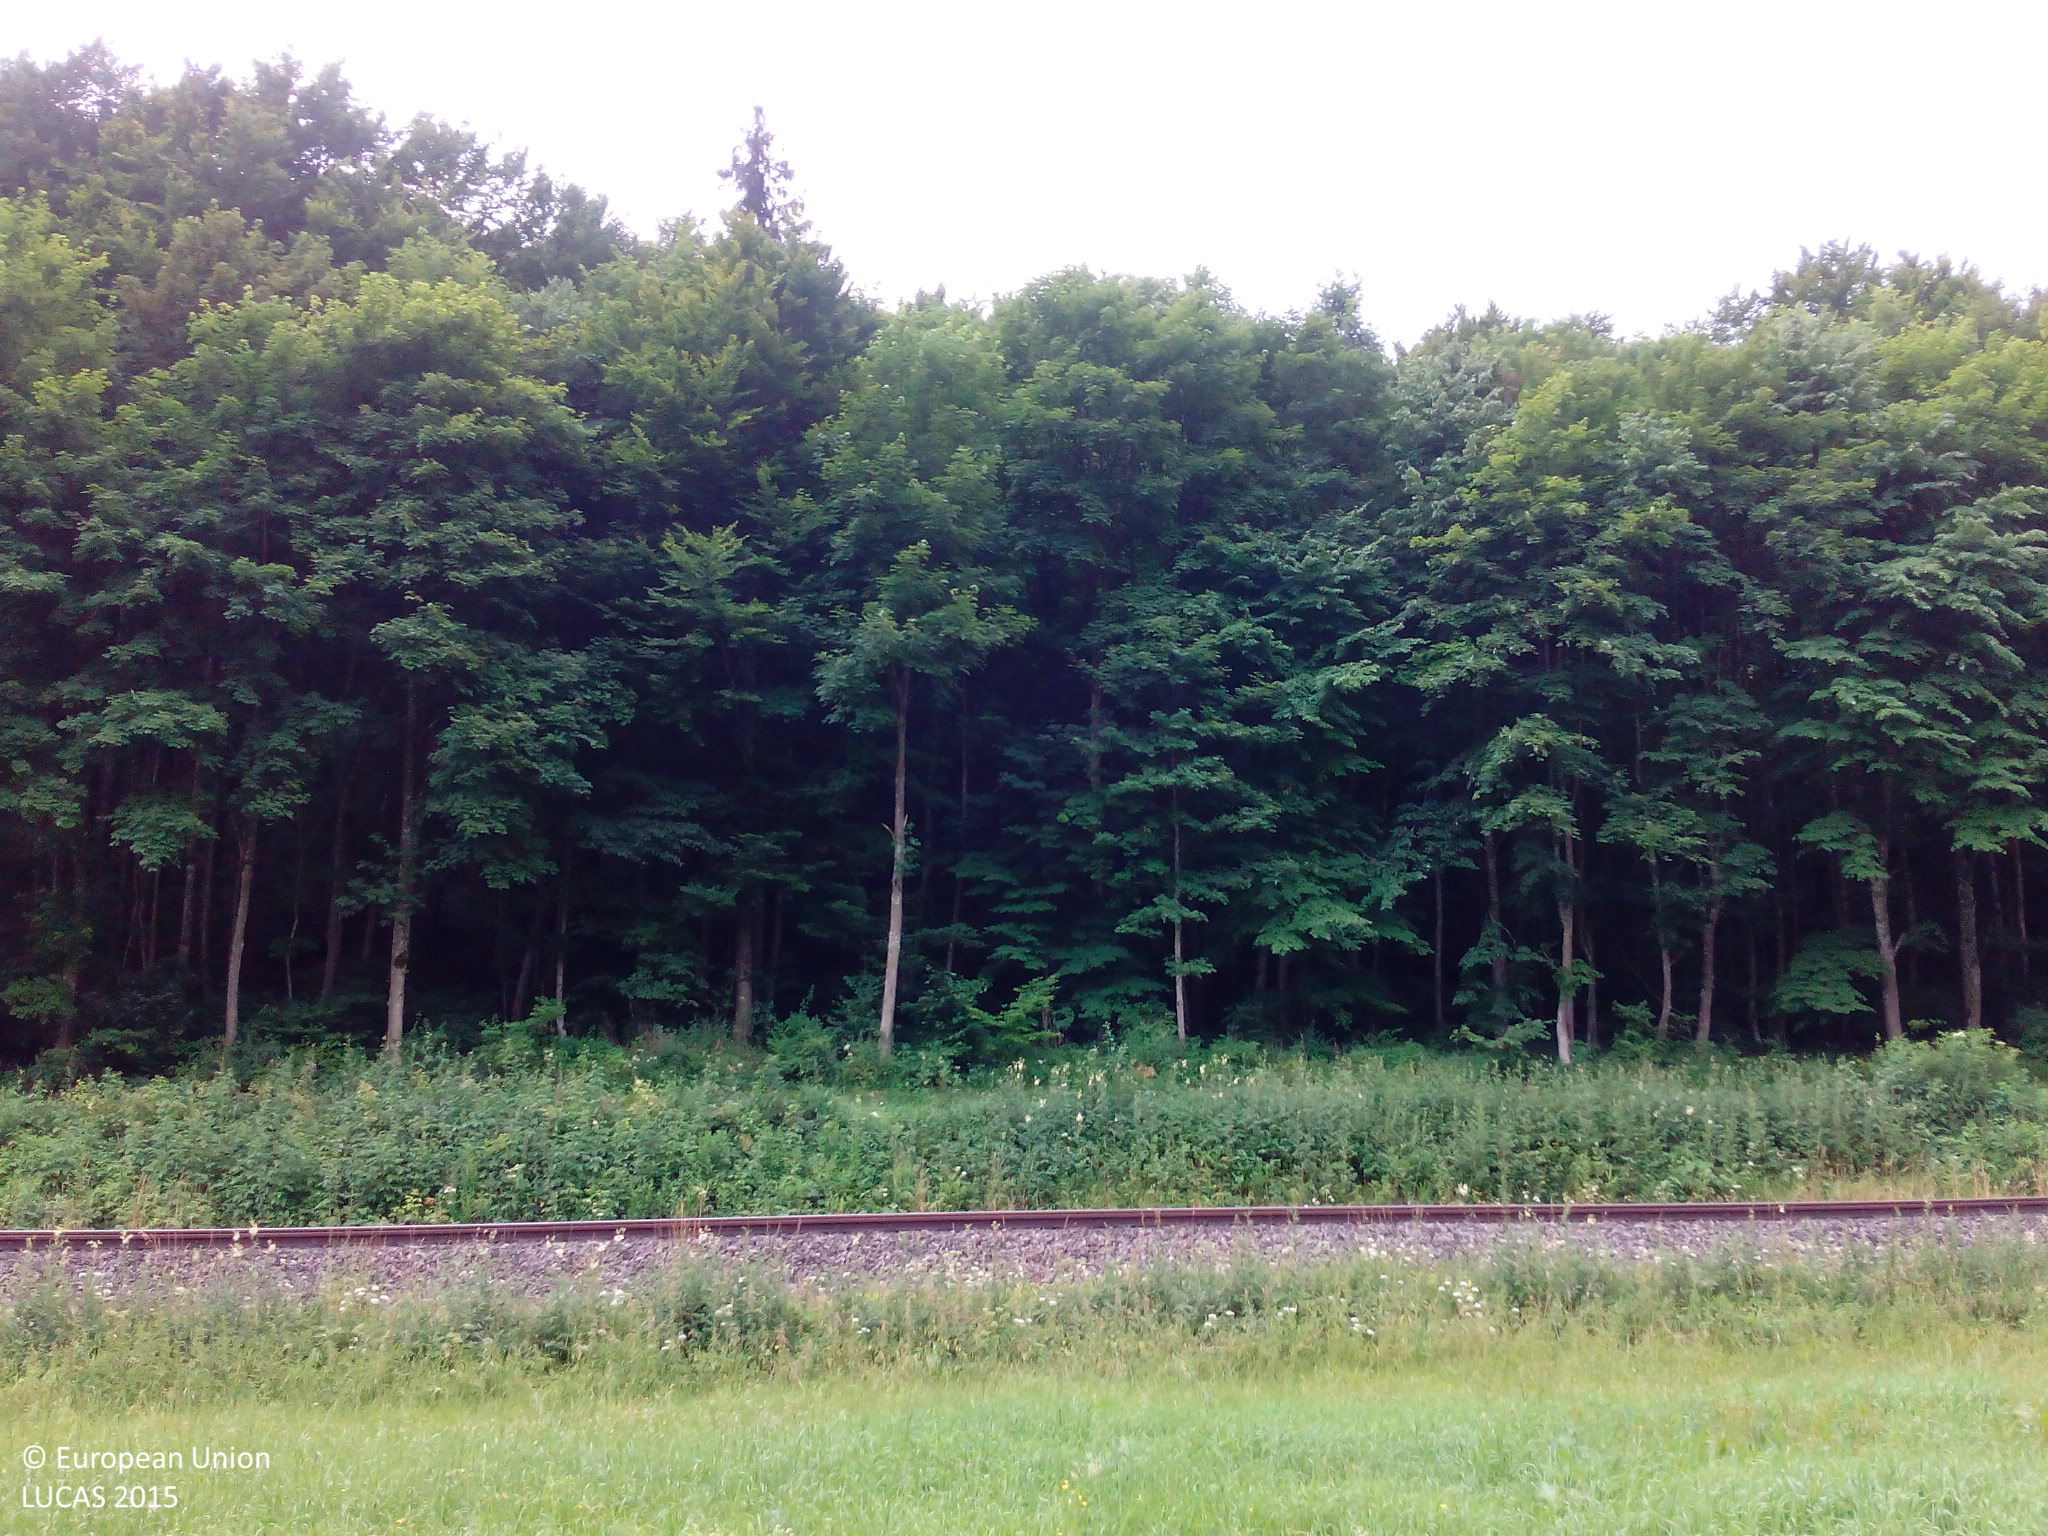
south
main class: Grassland
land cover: Grassland without tree/shrub cover
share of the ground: > 75 %
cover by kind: herbaceous plants 100 %
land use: Agriculture (excluding fallow land and kitchen gardens)
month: July
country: DE
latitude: 48.3670
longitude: 9.6897
